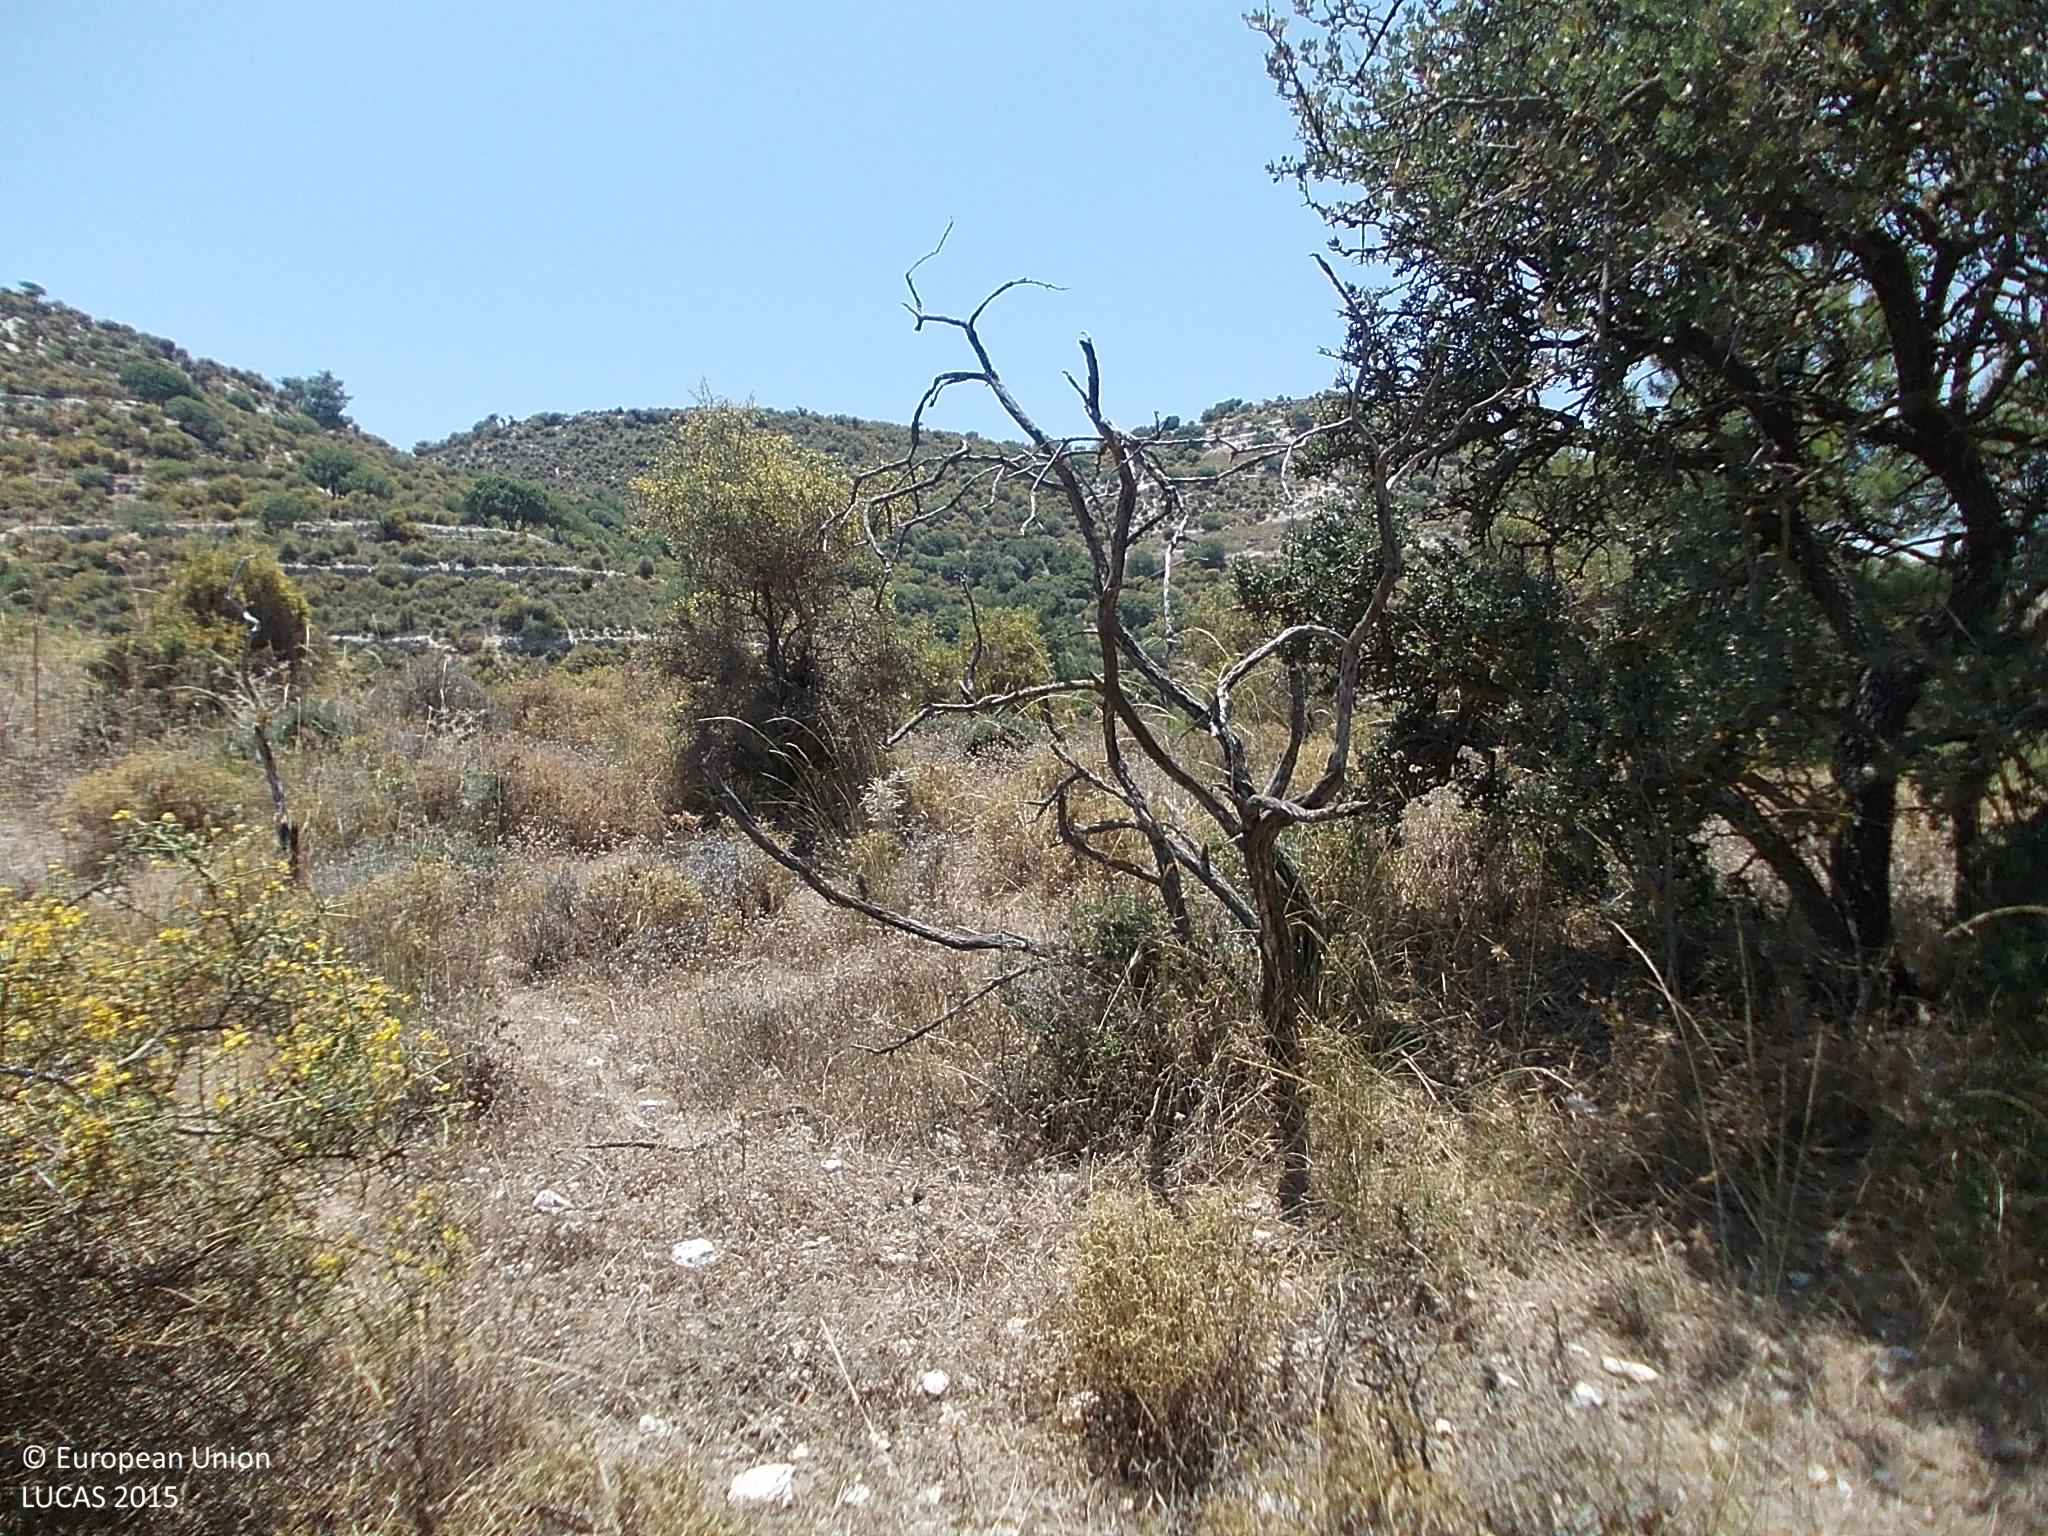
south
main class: Shrubland
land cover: Shrubland with sparse tree cover
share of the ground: 50 - 75 %
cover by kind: shrubs 65 %, herbaceous plants 15 %, unconsolidated bare surface 15 %, broadleaved forest trees 5 %
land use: Semi-natural and natural areas not in use
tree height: > 5 m
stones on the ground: 25 - 50 %
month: July
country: CY
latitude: 34.7370
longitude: 32.7077
